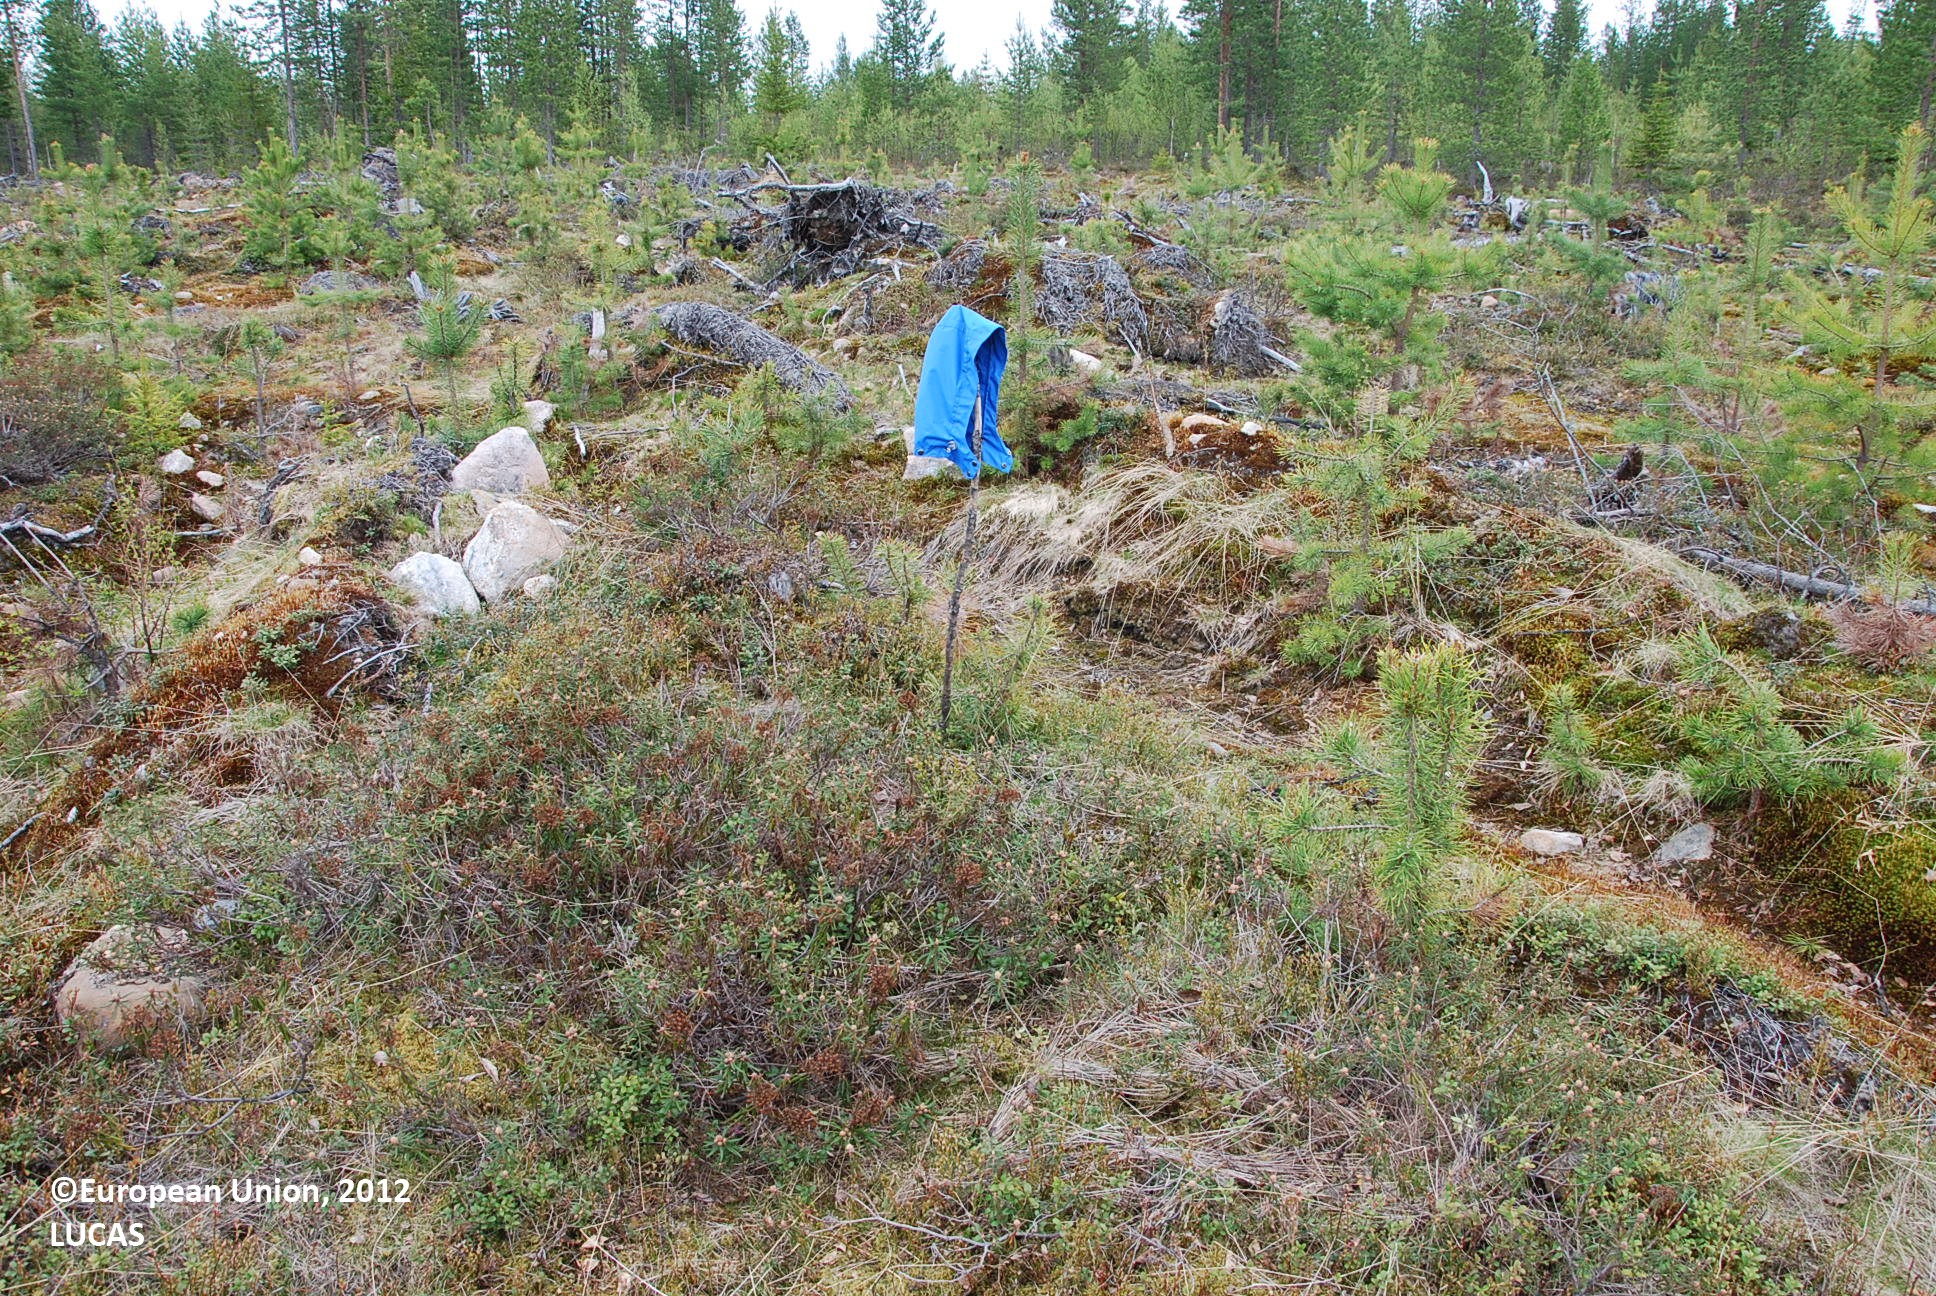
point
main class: Woodland
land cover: Pine dominated coniferous woodland
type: boreal forest
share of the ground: 10 - 25 %
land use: Forestry
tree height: < 5 m
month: June
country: FI
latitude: 66.8094
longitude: 28.1759
